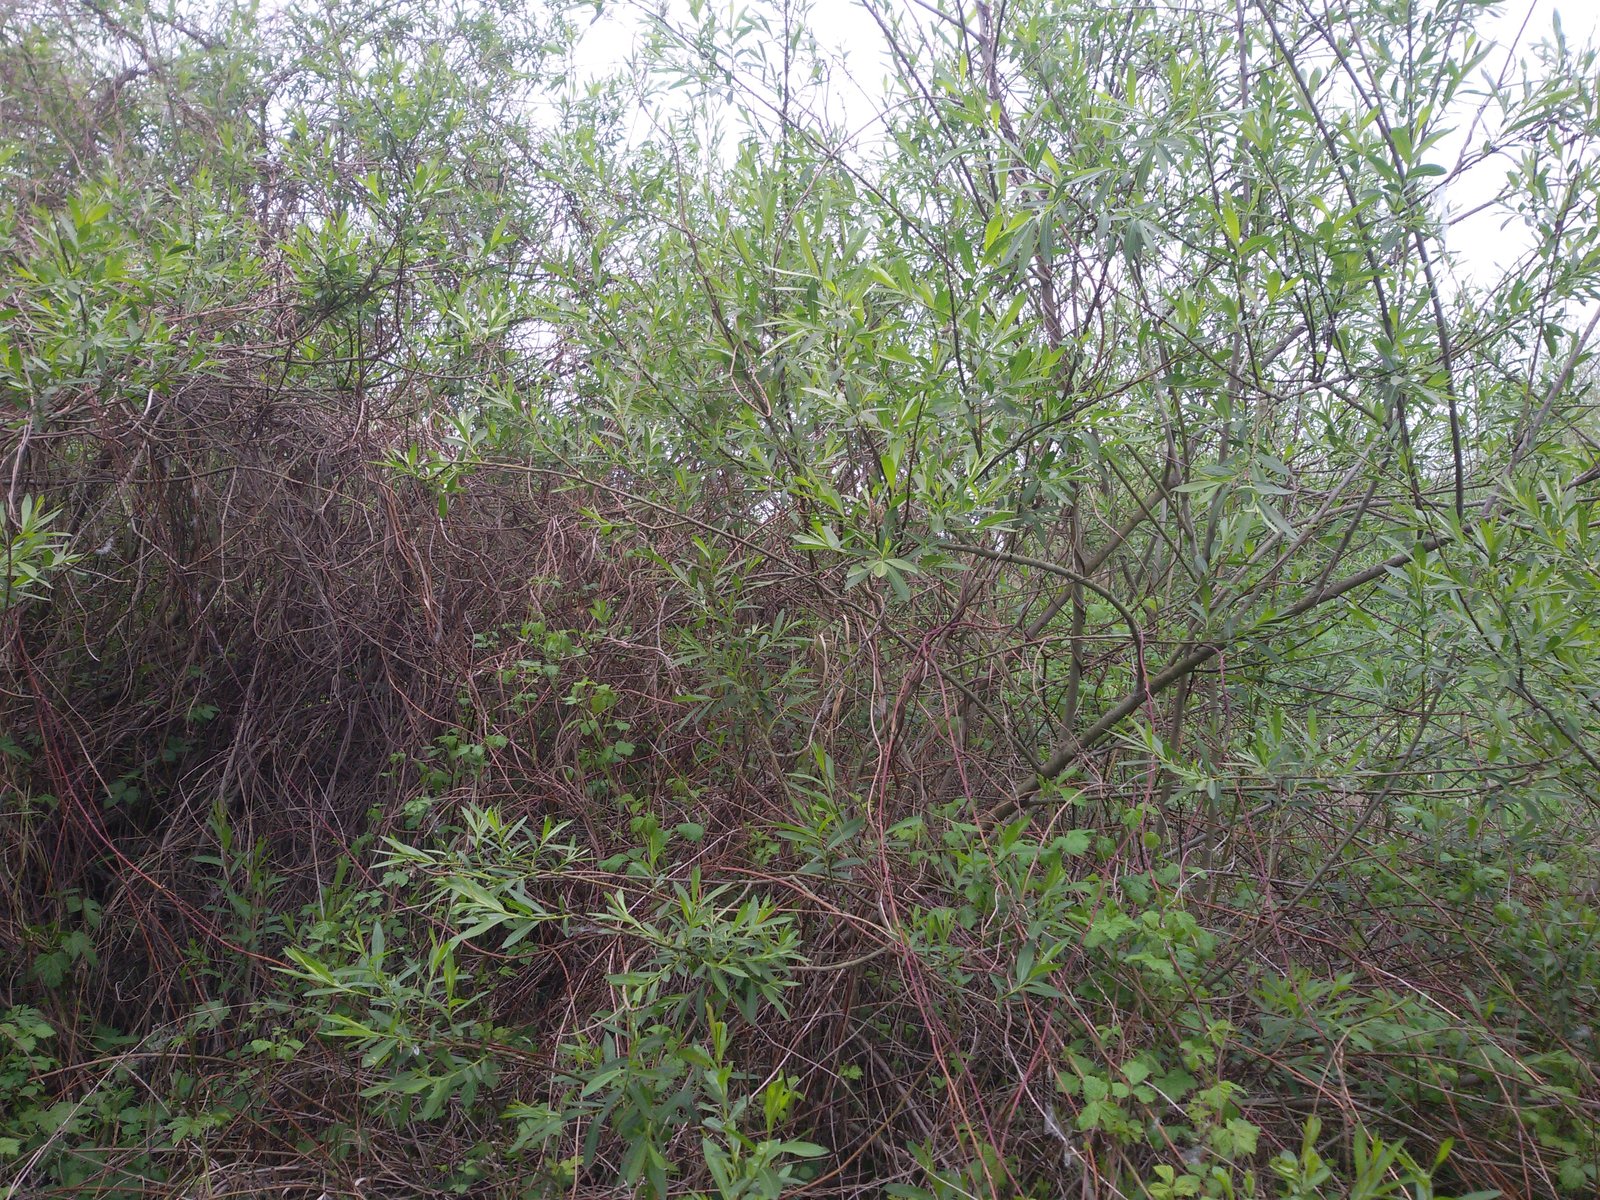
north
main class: Shrubland
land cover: Shrubland without tree cover
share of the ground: 25 - 50 %
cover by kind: herbaceous plants 70 %, shrubs 30 %
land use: Semi-natural and natural areas not in use
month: May
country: PL
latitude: 50.4296
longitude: 21.3813
